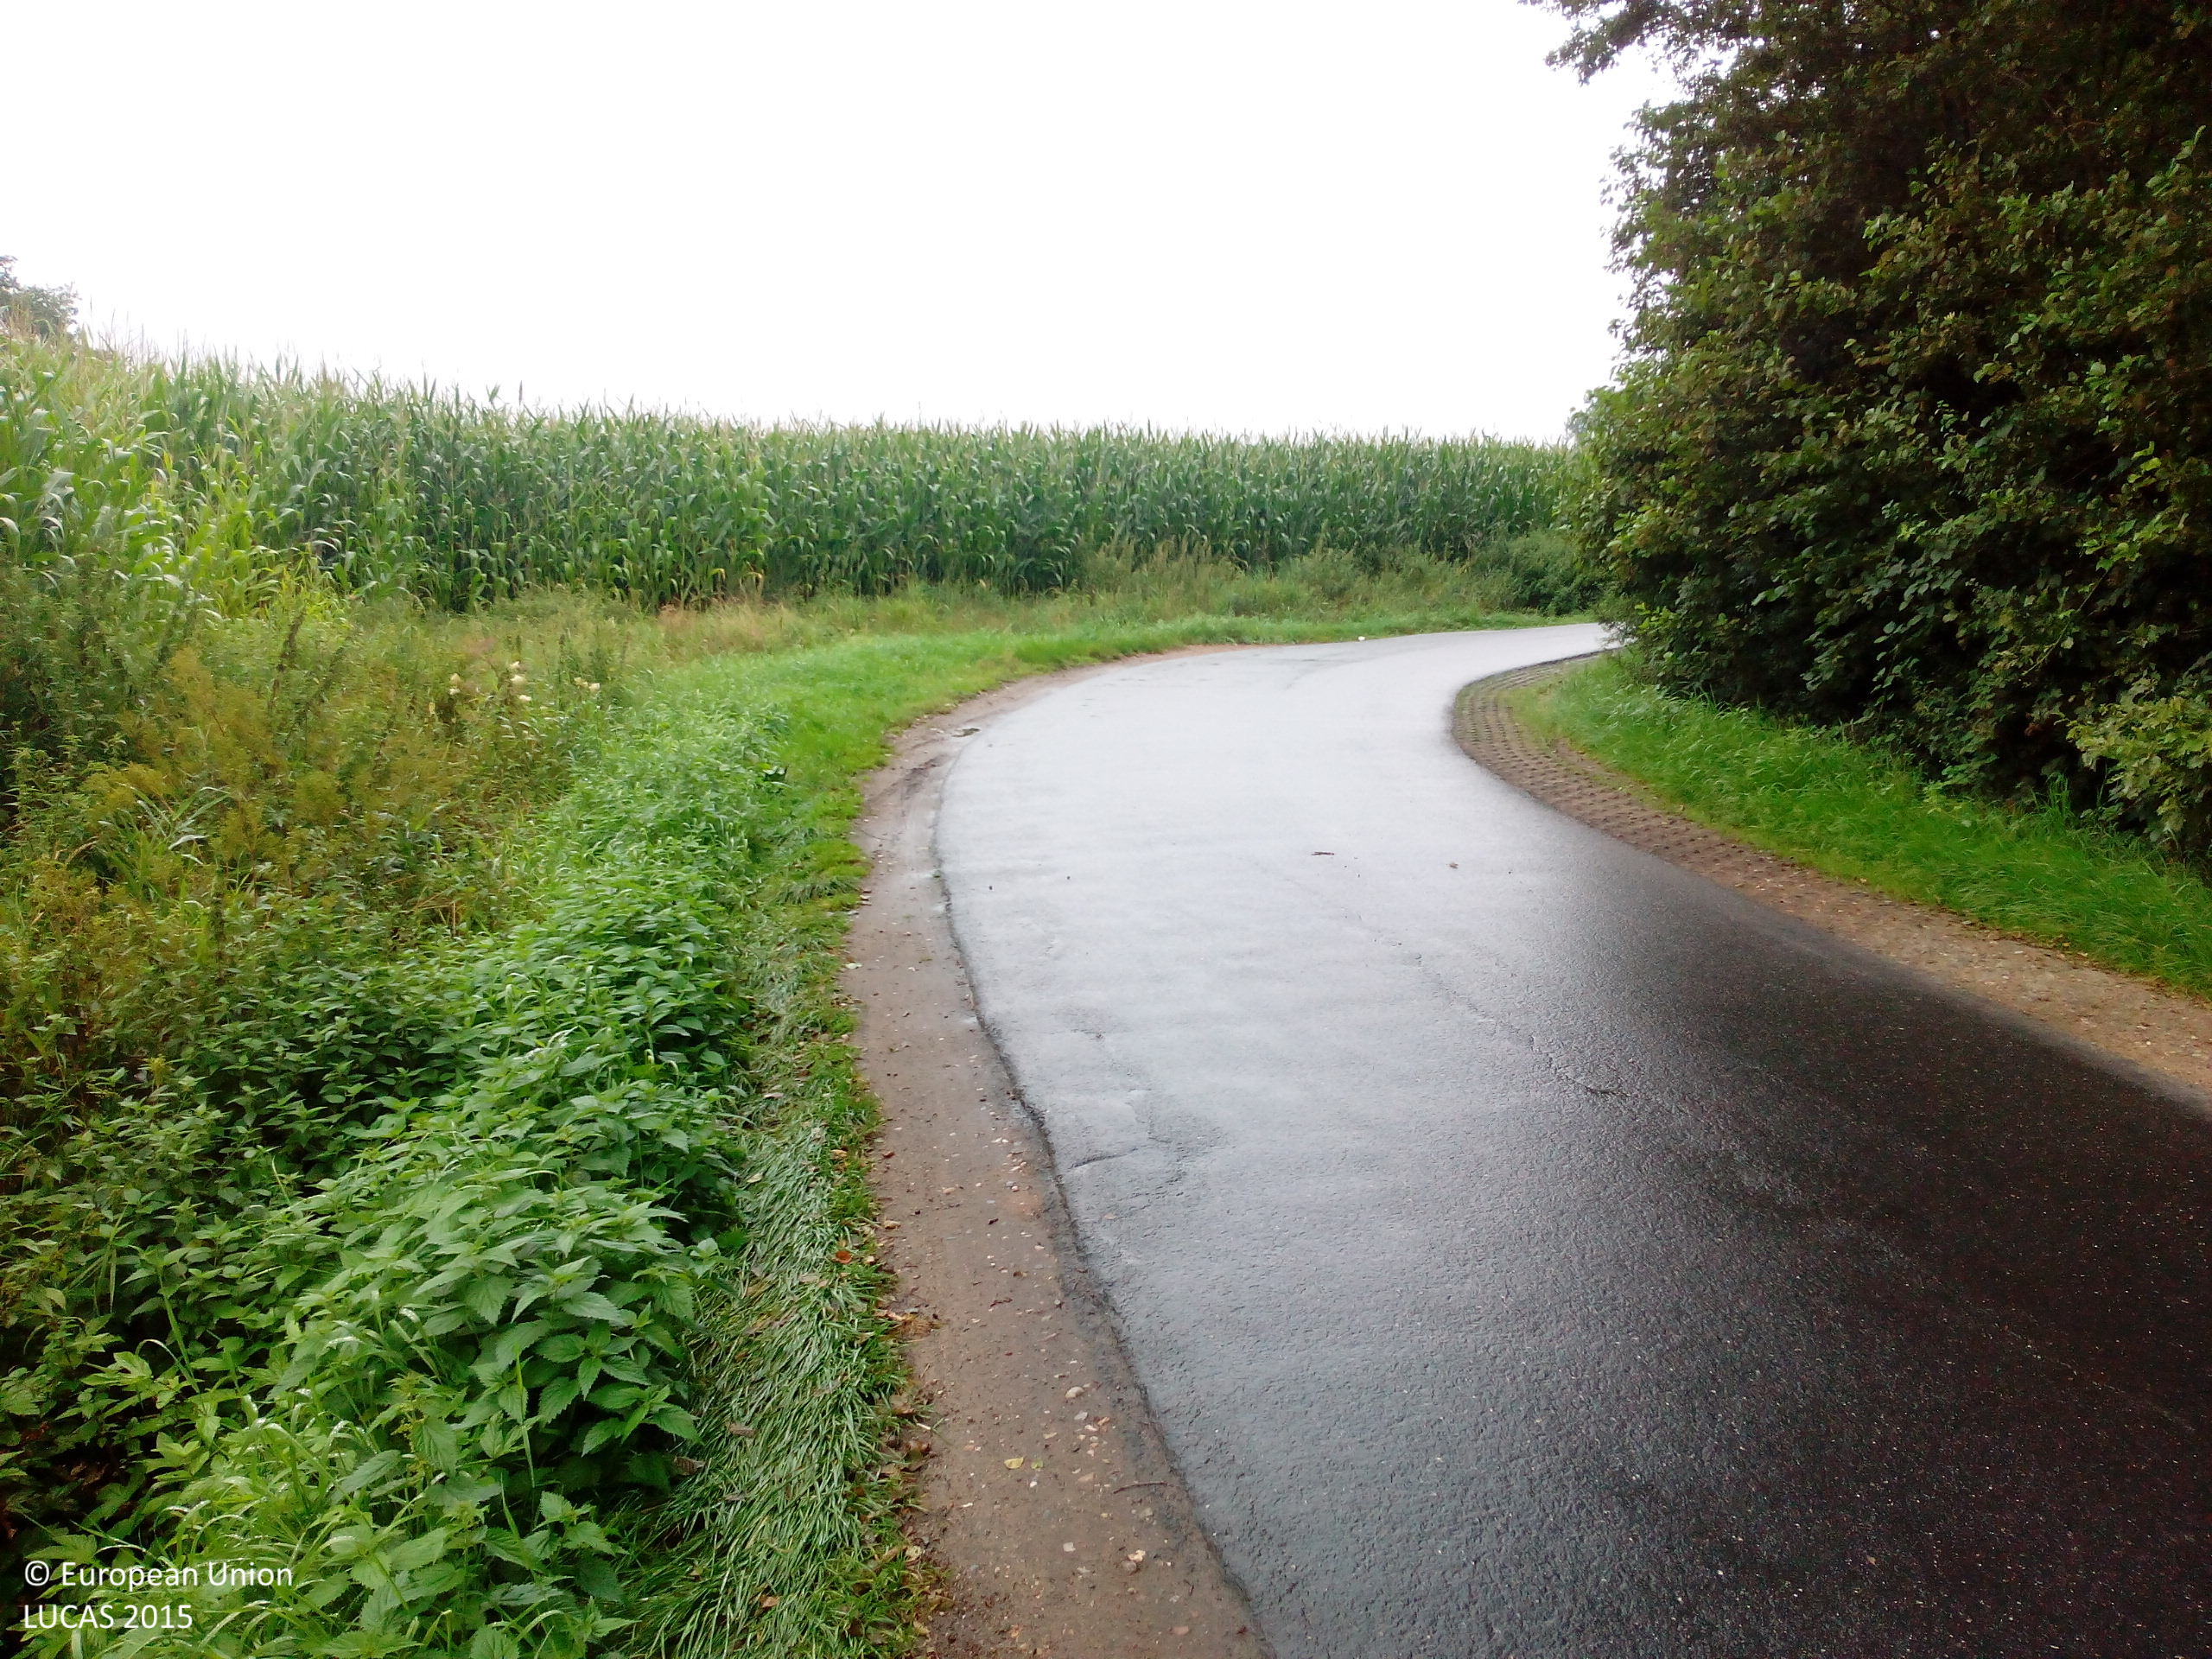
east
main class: Cropland
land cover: Maize
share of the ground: > 75 %
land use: Agriculture (excluding fallow land and kitchen gardens)
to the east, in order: Maize
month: August
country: DE
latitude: 53.7613
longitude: 9.8939
